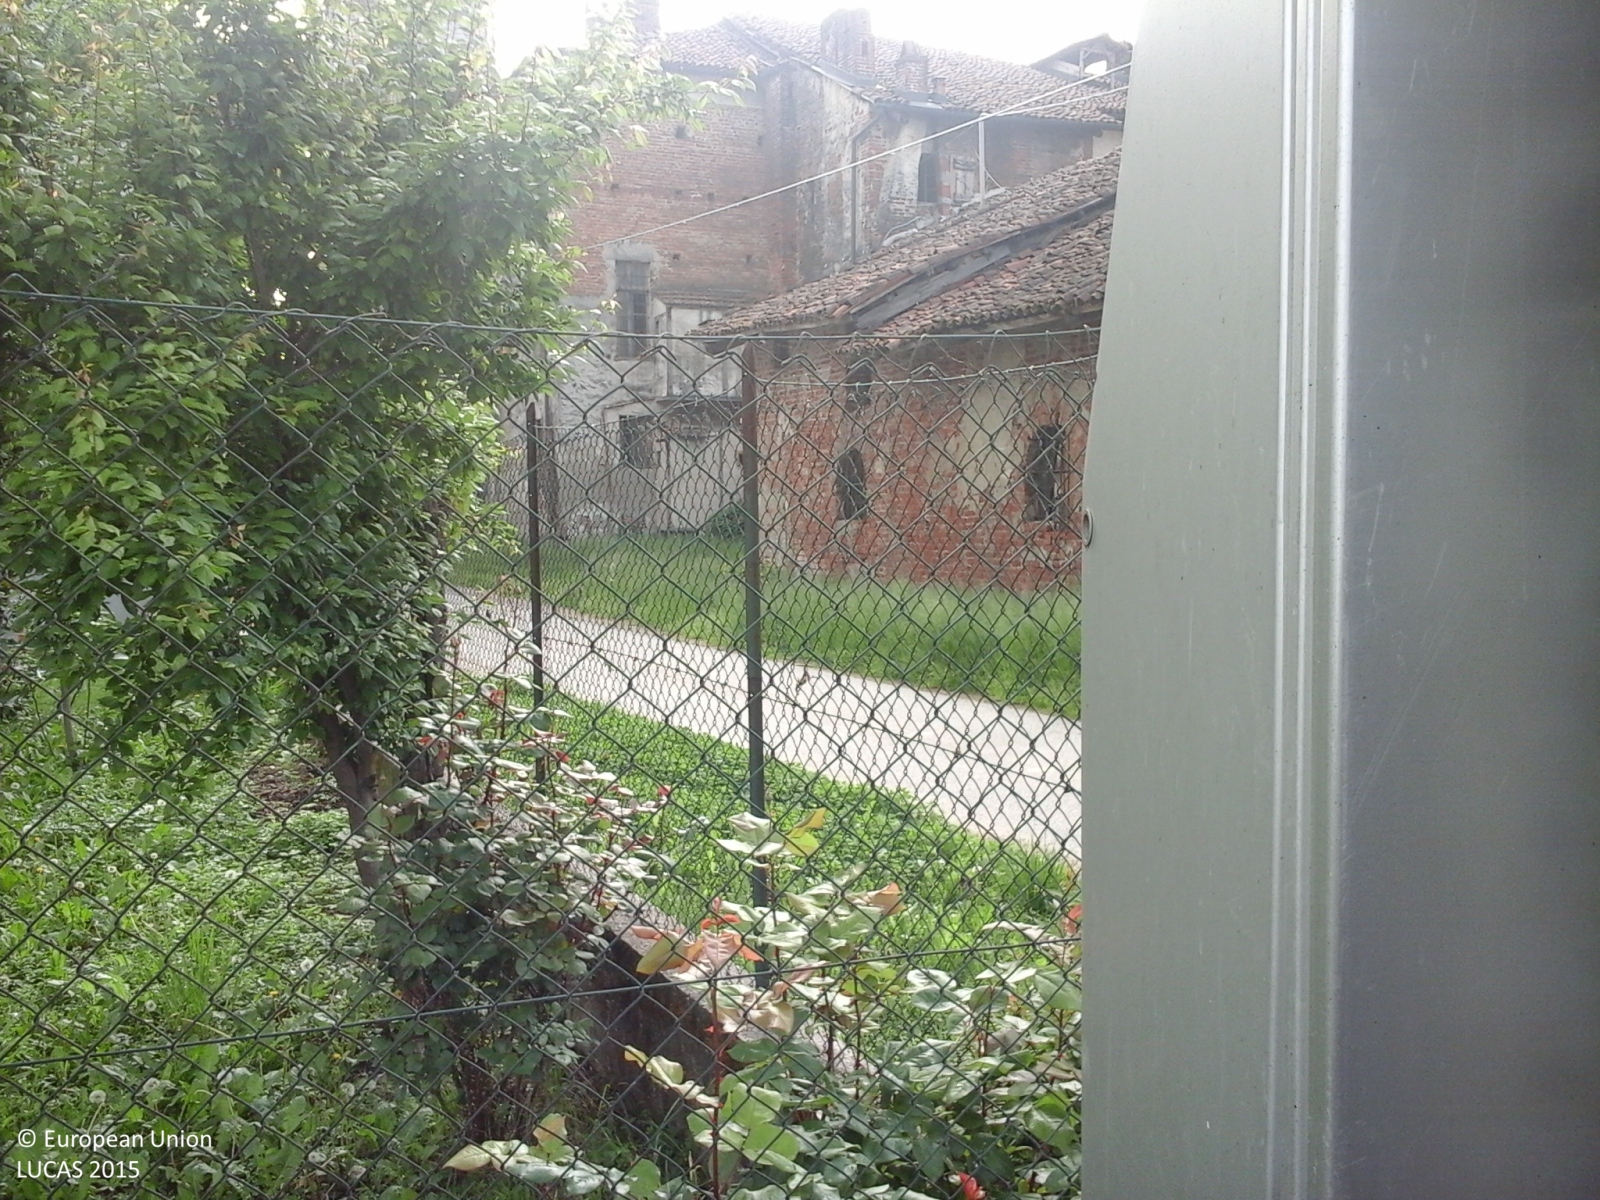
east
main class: Cropland
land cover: Temporary grasslands
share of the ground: > 75 %
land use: Agriculture (excluding fallow land and kitchen gardens)
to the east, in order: Temporary grasslands; Ditches and canals; Artificial constructions in urban areas; Grass margins; Maize; Temporary grasslands; Abandoned hedges; Ditches and canals; Grass margins; Triticale
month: May
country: IT
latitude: 44.6317
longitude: 7.6978
